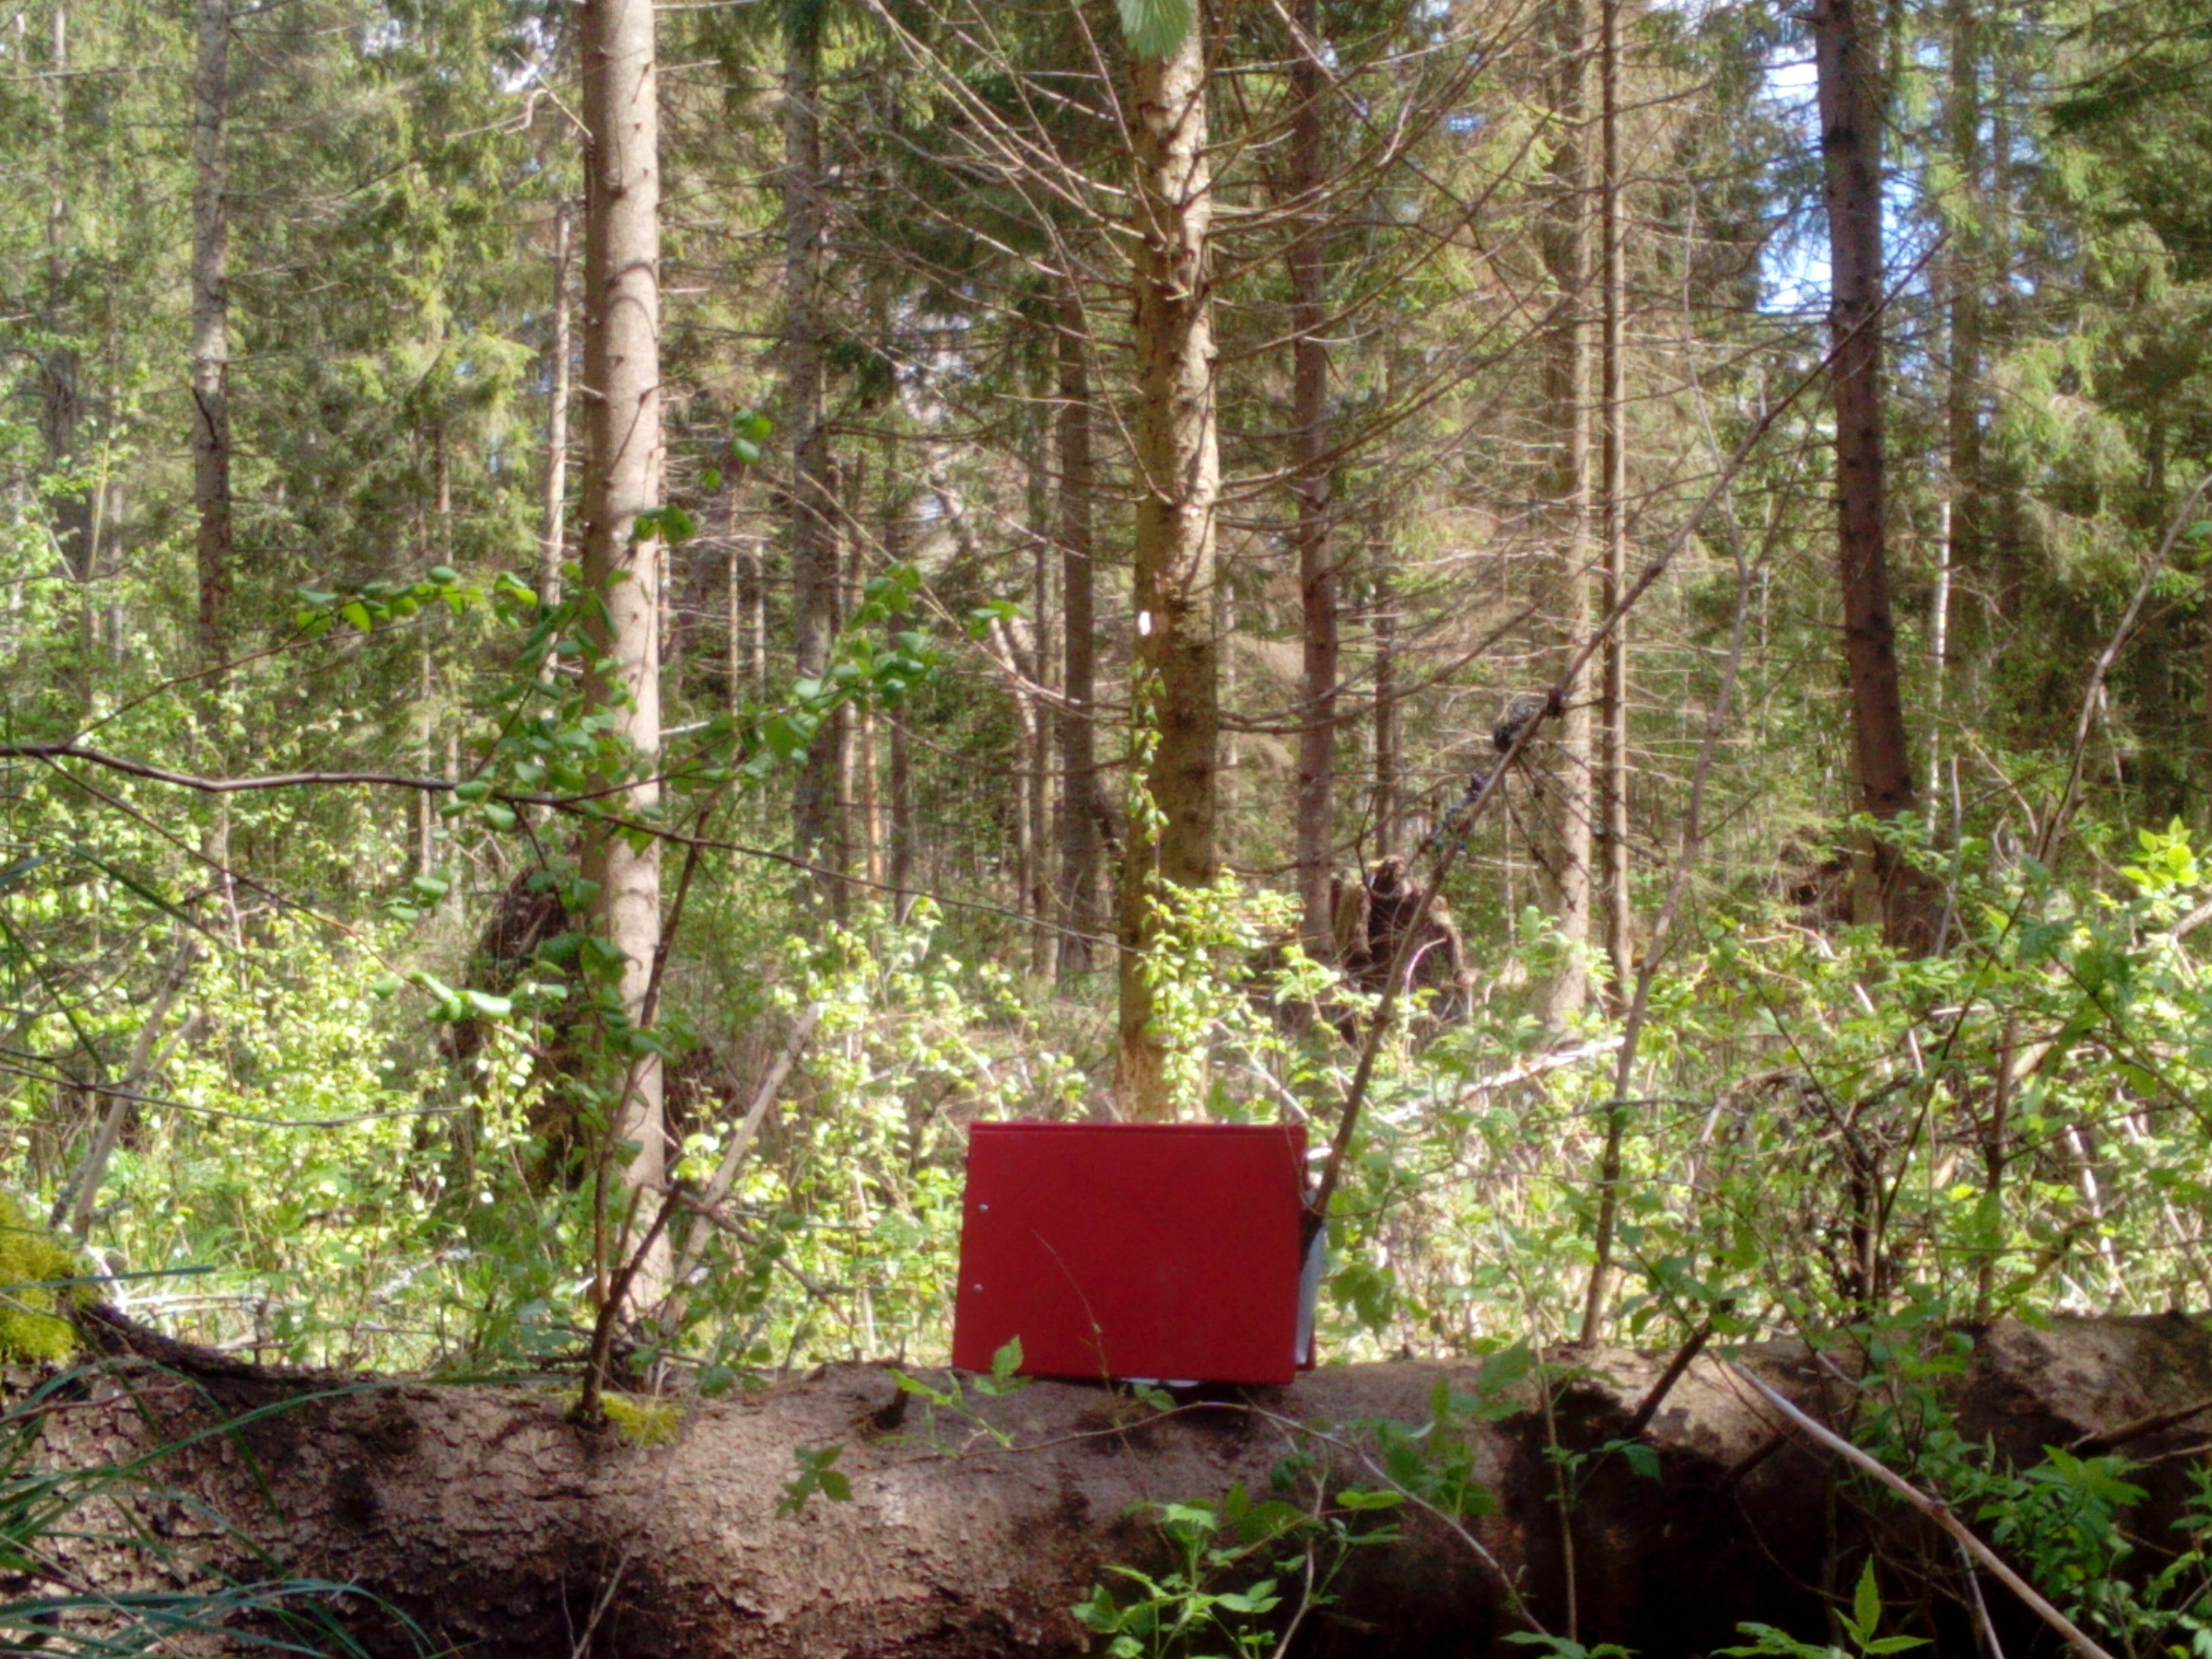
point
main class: Woodland
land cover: Spruce dominated mixed woodland
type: hemiboreal forest and nemoral coniferous forest and mixed broadleaved-coniferous forest
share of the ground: > 75 %
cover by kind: coniferous forest trees 75 %, broadleaved forest trees 25 %
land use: Forestry
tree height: > 5 m
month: May
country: LV
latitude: 56.7404
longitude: 22.8636
